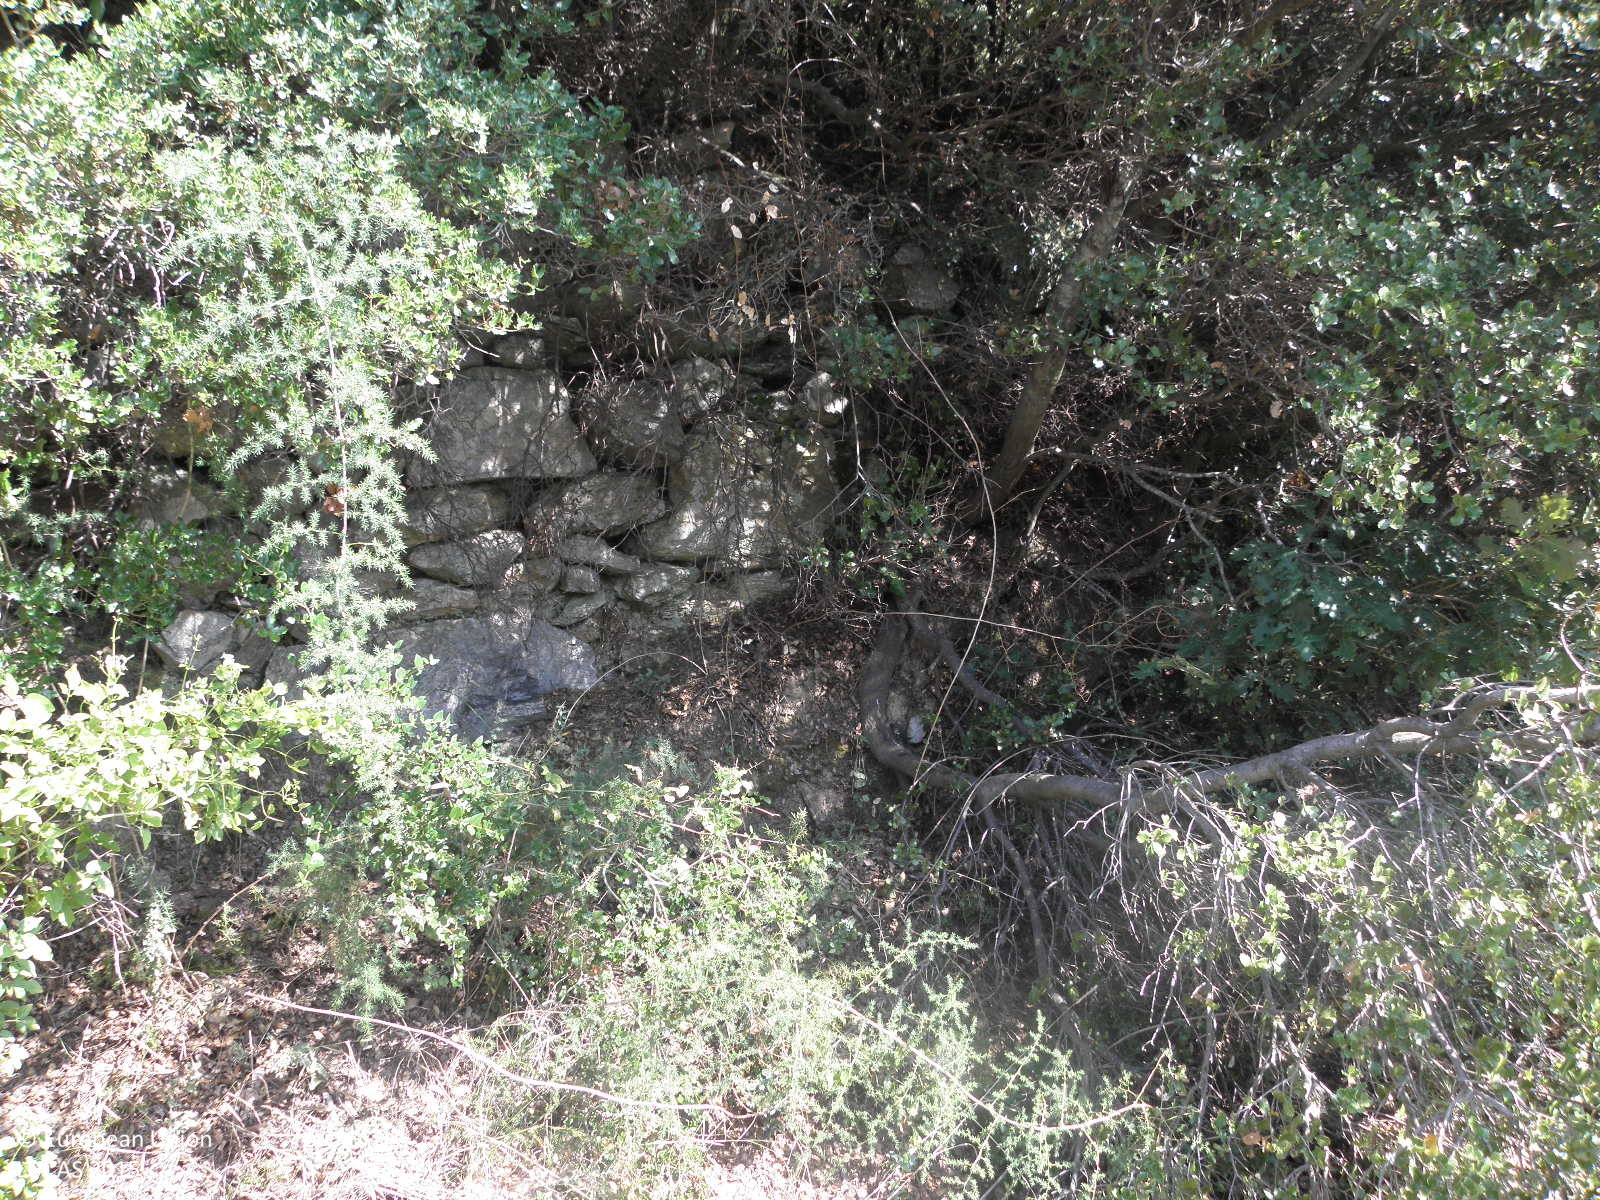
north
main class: Shrubland
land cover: Shrubland with sparse tree cover
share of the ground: > 75 %
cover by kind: shrubs 95 %, broadleaved forest trees 5 %
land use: Semi-natural and natural areas not in use
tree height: > 5 m
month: August
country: GR
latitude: 39.9304
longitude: 22.5738
